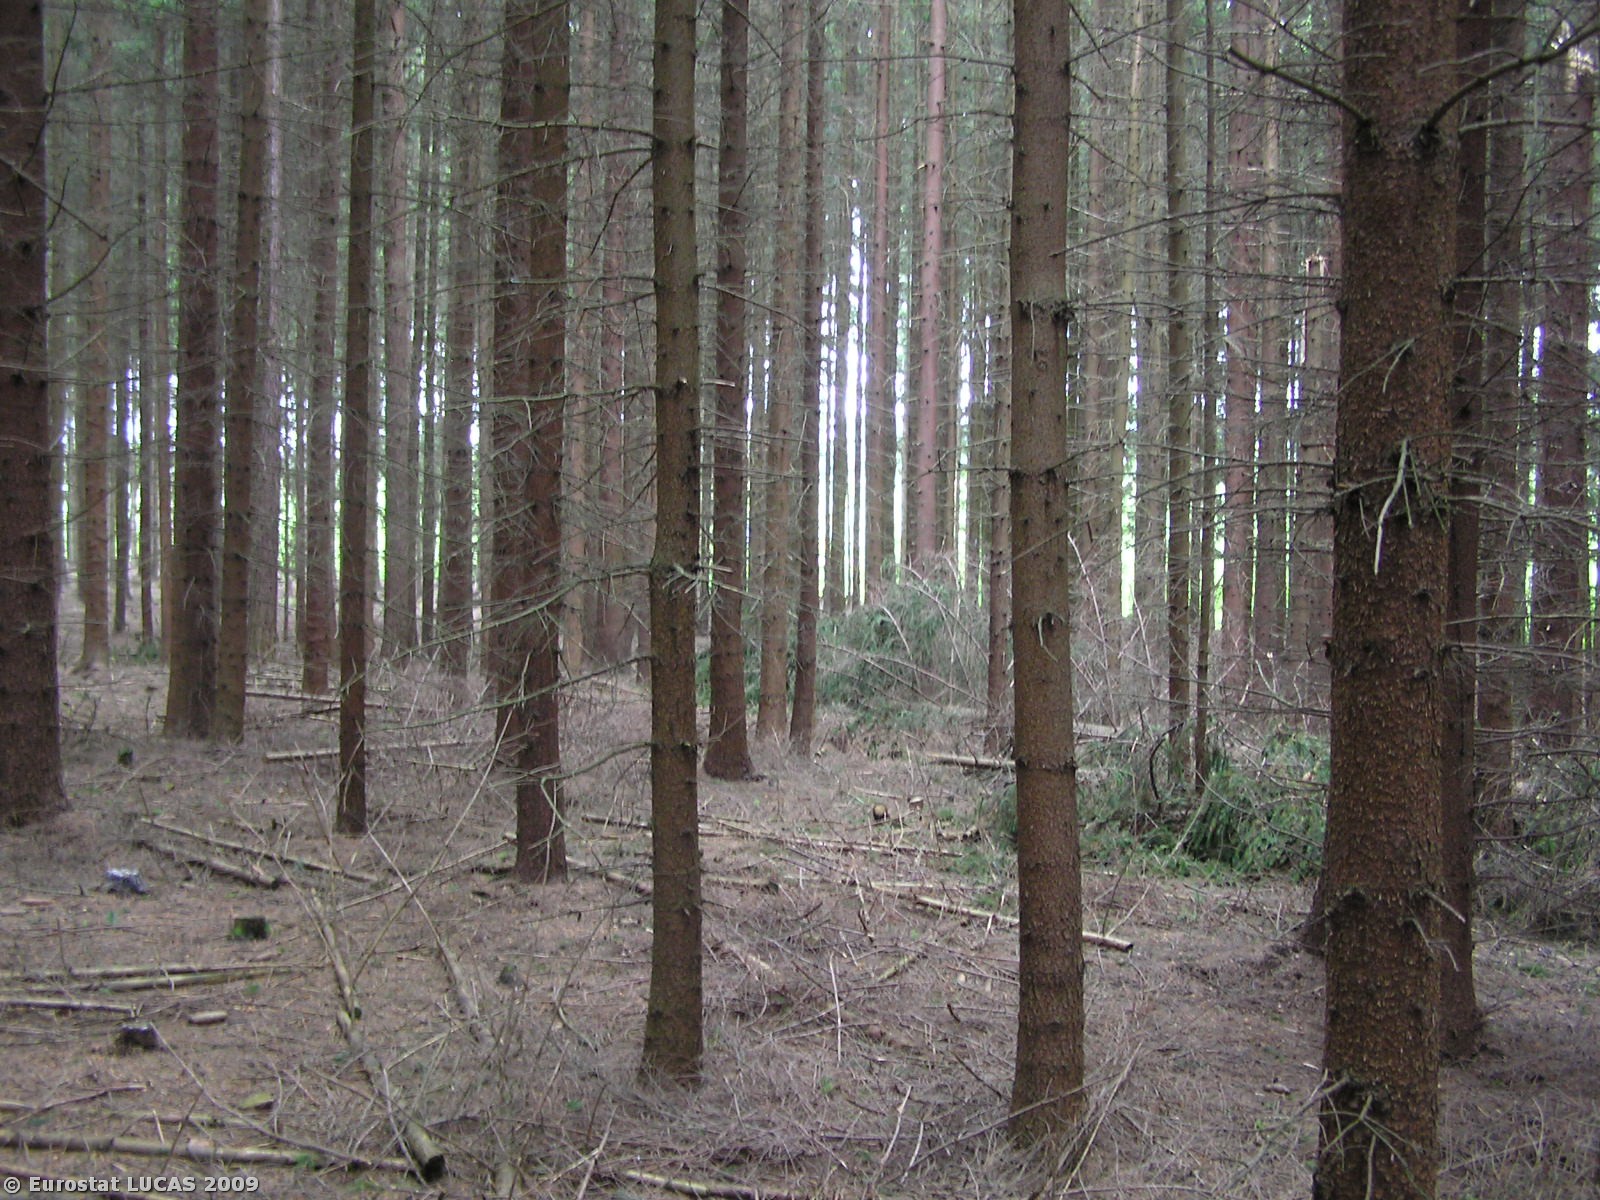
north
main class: Woodland
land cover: Coniferous woodland
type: hemiboreal forest and nemoral coniferous forest and mixed broadleaved-coniferous forest
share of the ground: > 75 %
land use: Forestry
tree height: > 5 m
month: May
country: CZ
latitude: 49.3192
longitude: 14.9686
